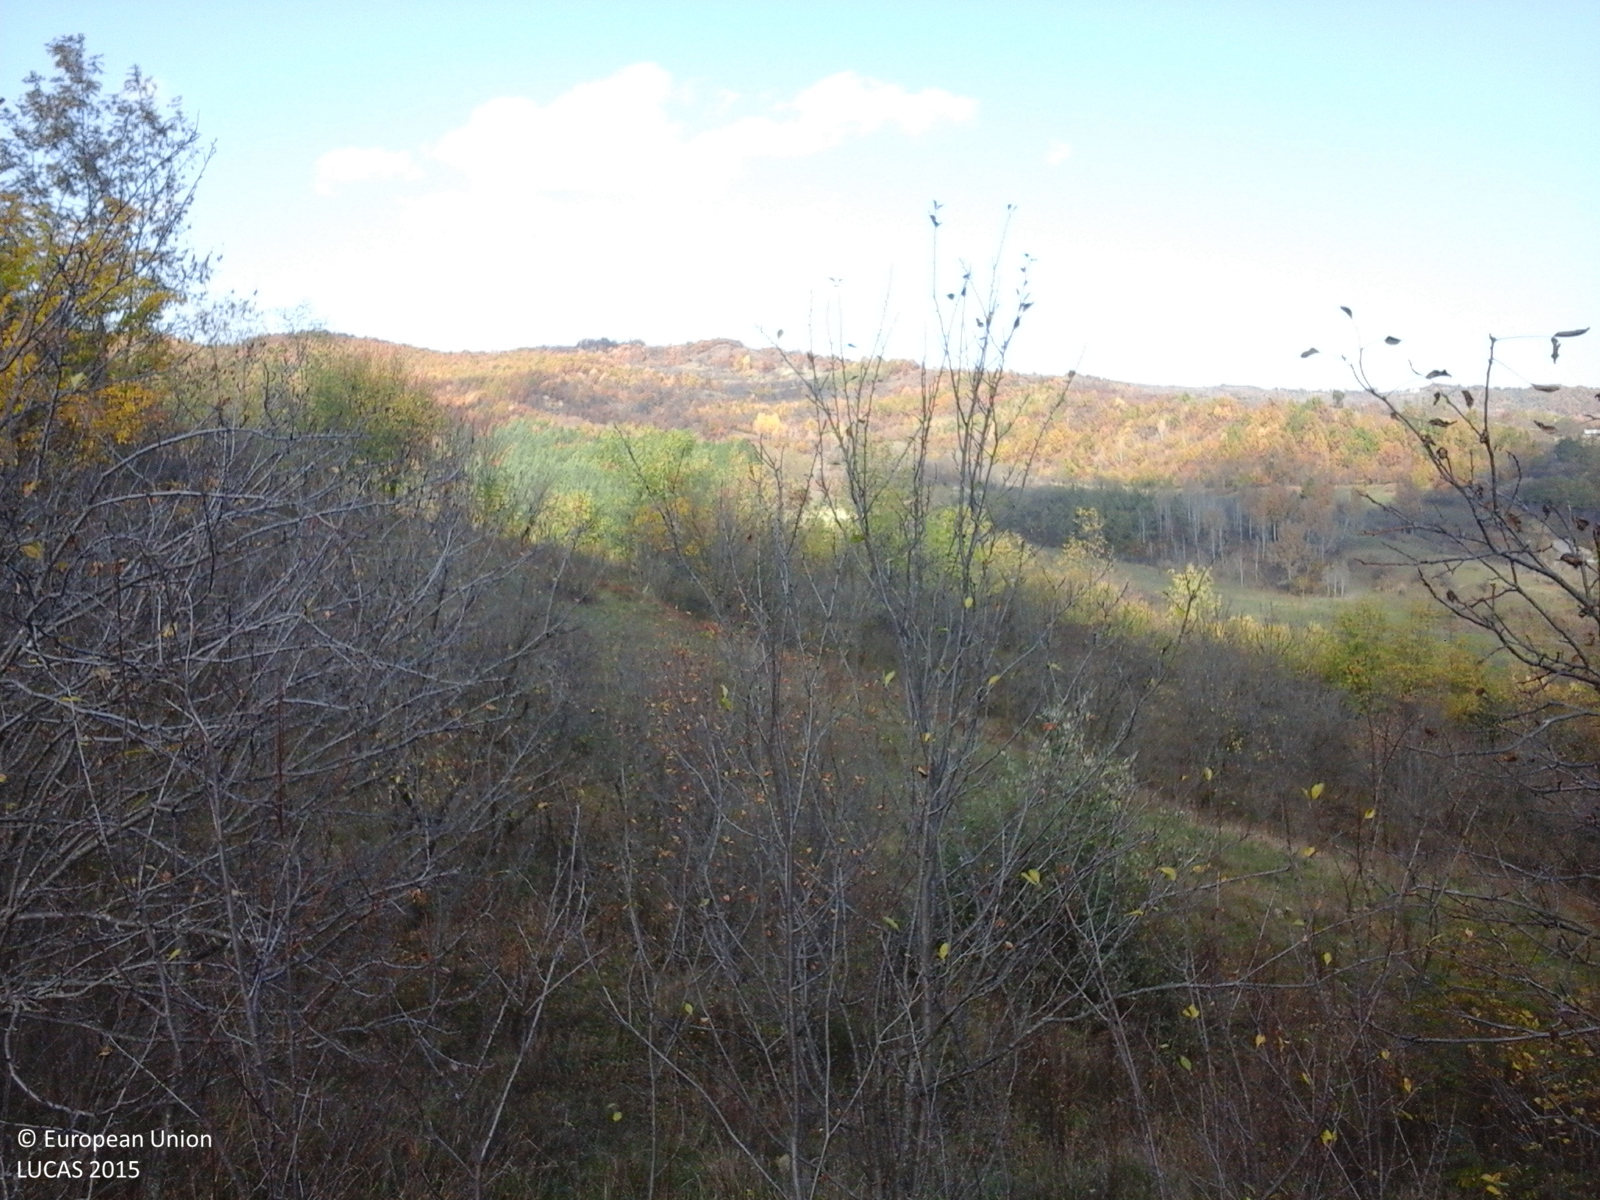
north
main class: Grassland
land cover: Grassland with sparse tree/shrub cover
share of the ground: > 75 %
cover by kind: herbaceous plants 85 %, shrubs 10 %, broadleaved forest trees 5 %
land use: Agriculture (excluding fallow land and kitchen gardens)
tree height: > 5 m
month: October
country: RO
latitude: 45.6070
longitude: 26.9746
